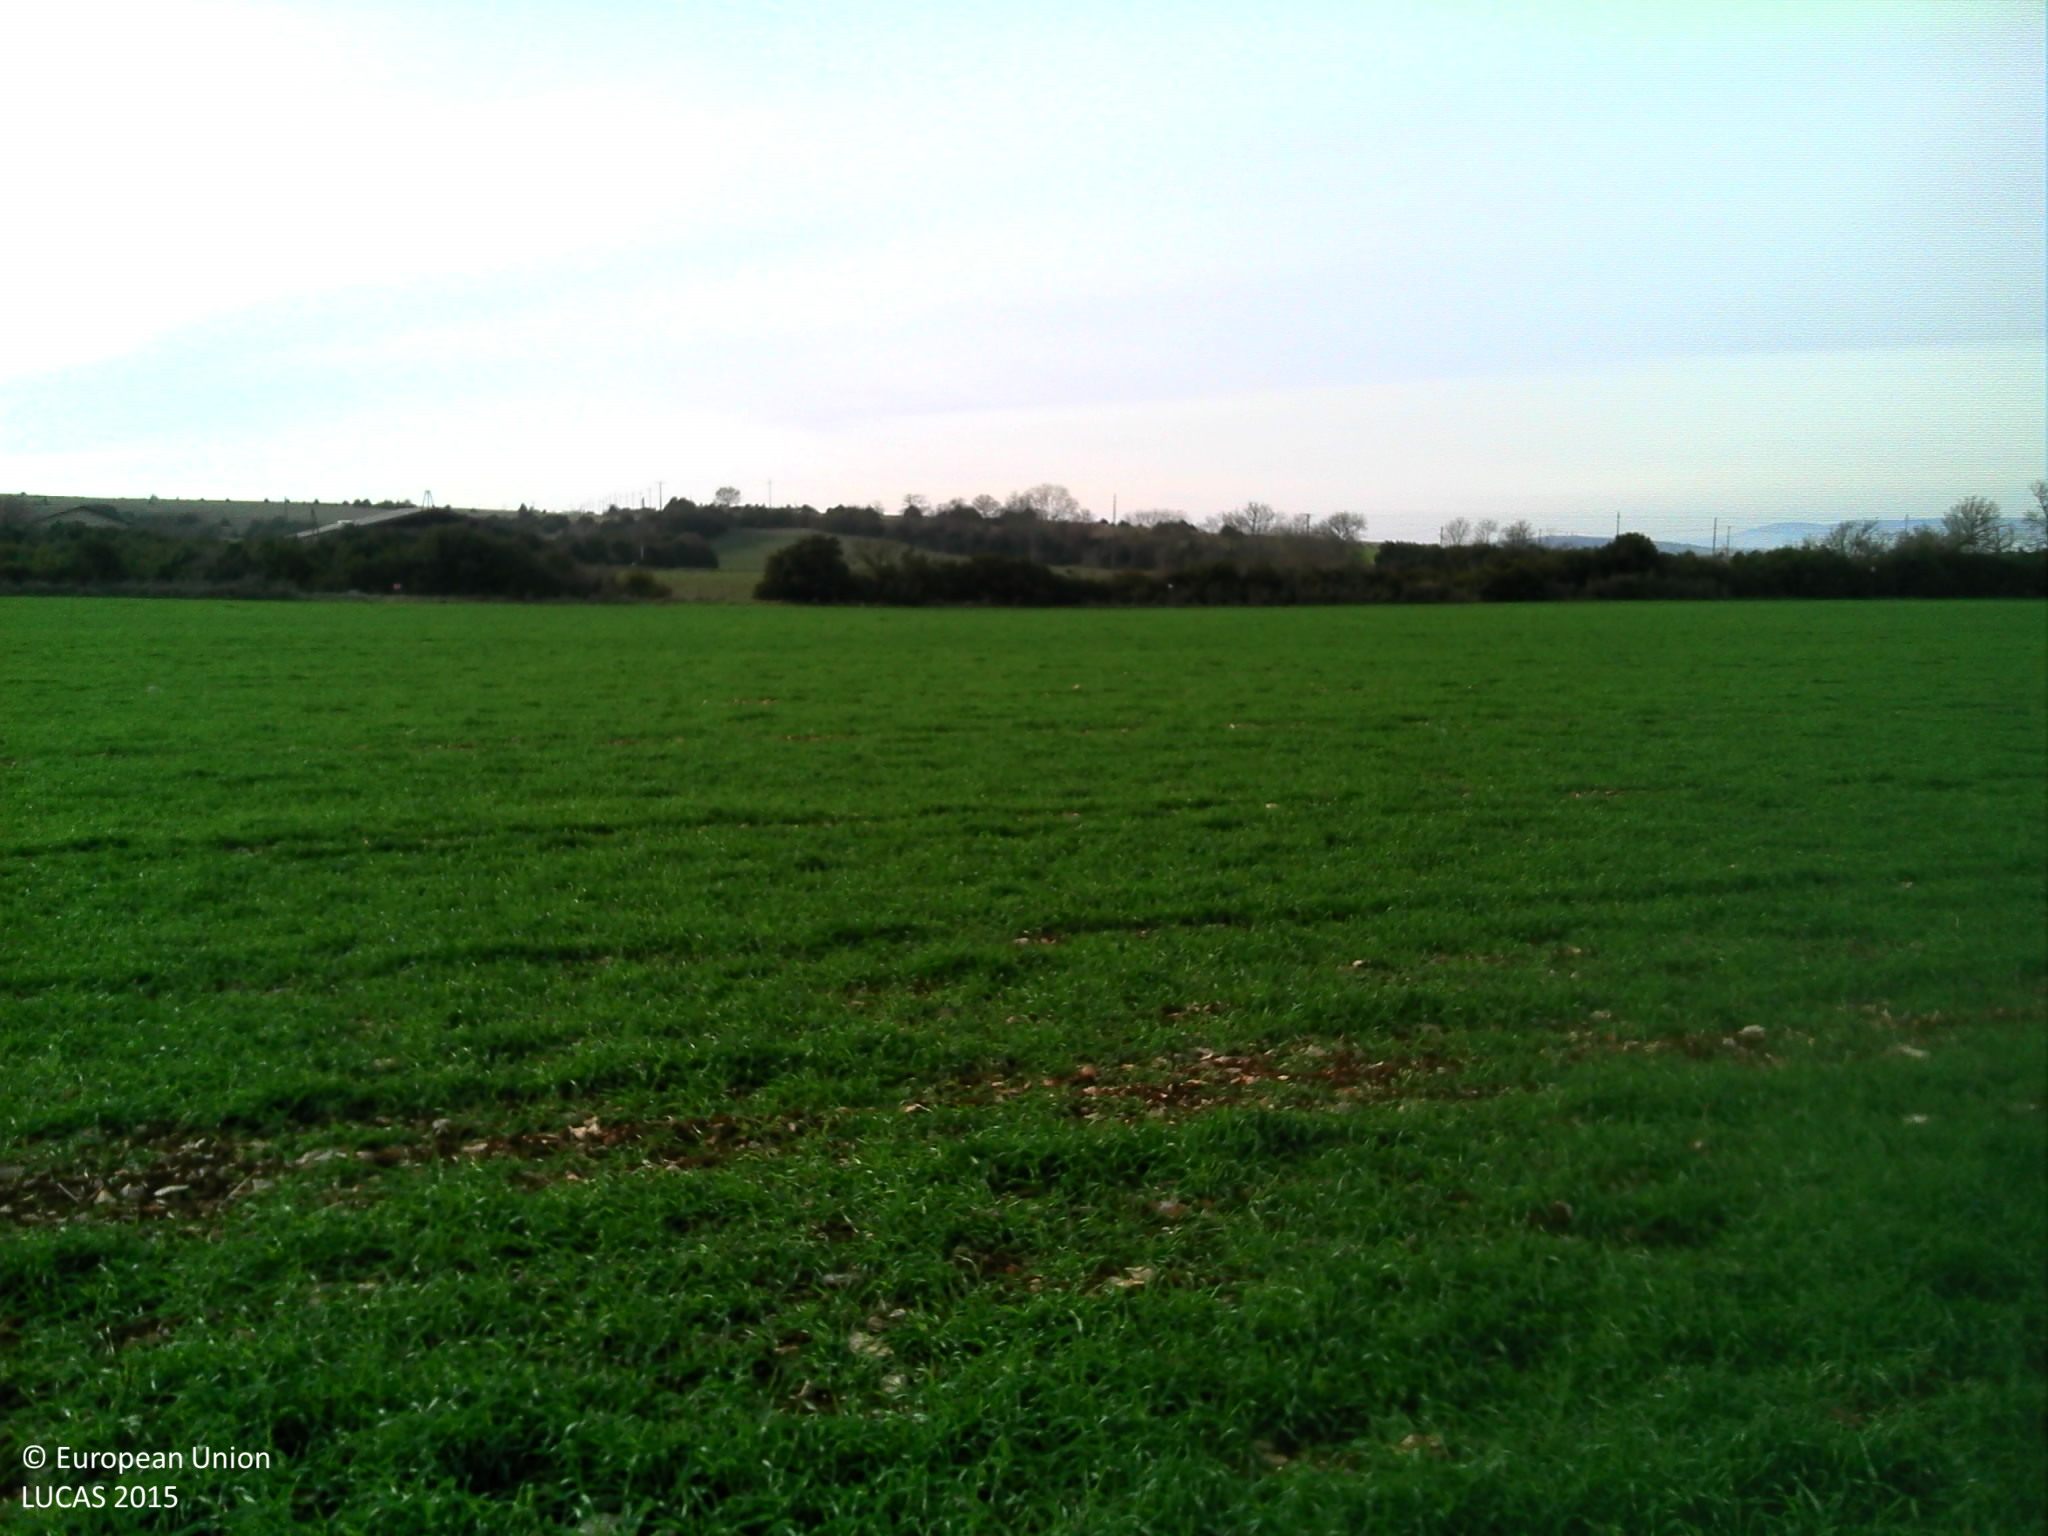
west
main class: Cropland
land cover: Barley
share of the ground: > 75 %
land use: Agriculture (excluding fallow land and kitchen gardens)
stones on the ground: 25 - 50 %
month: November
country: FR
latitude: 44.0487
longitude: 3.1041
